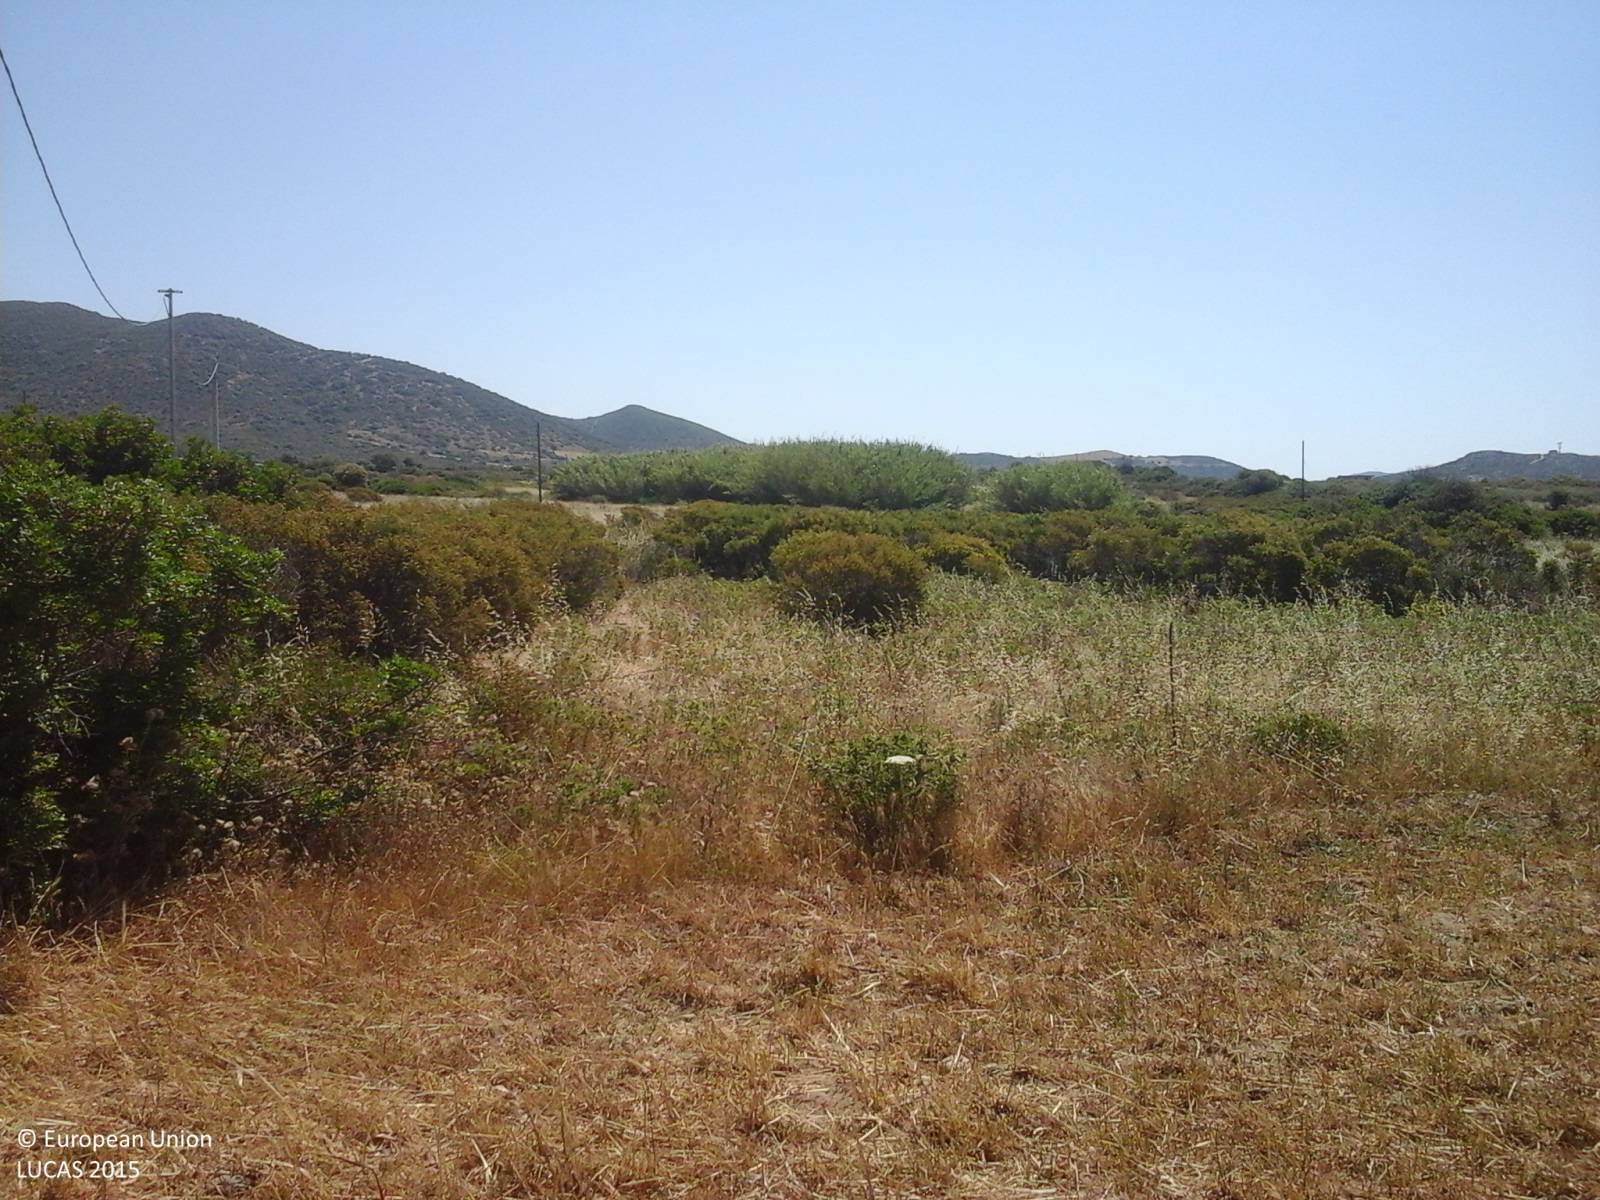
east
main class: Shrubland
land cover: Shrubland without tree cover
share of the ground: > 75 %
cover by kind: herbaceous plants 60 %, consolidated bare surface 25 %, shrubs 15 %
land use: Agriculture (excluding fallow land and kitchen gardens)
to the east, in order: Shrubland without tree cover; Dry stone walls; Tracks; Electric lines; Shrubland without tree cover; Grassland without tree/shrub cover; Electric lines; Grassland without tree/shrub cover; Abandoned hedges; Grassland without tree/shrub cover
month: June
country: IT
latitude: 38.9903
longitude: 8.6808
